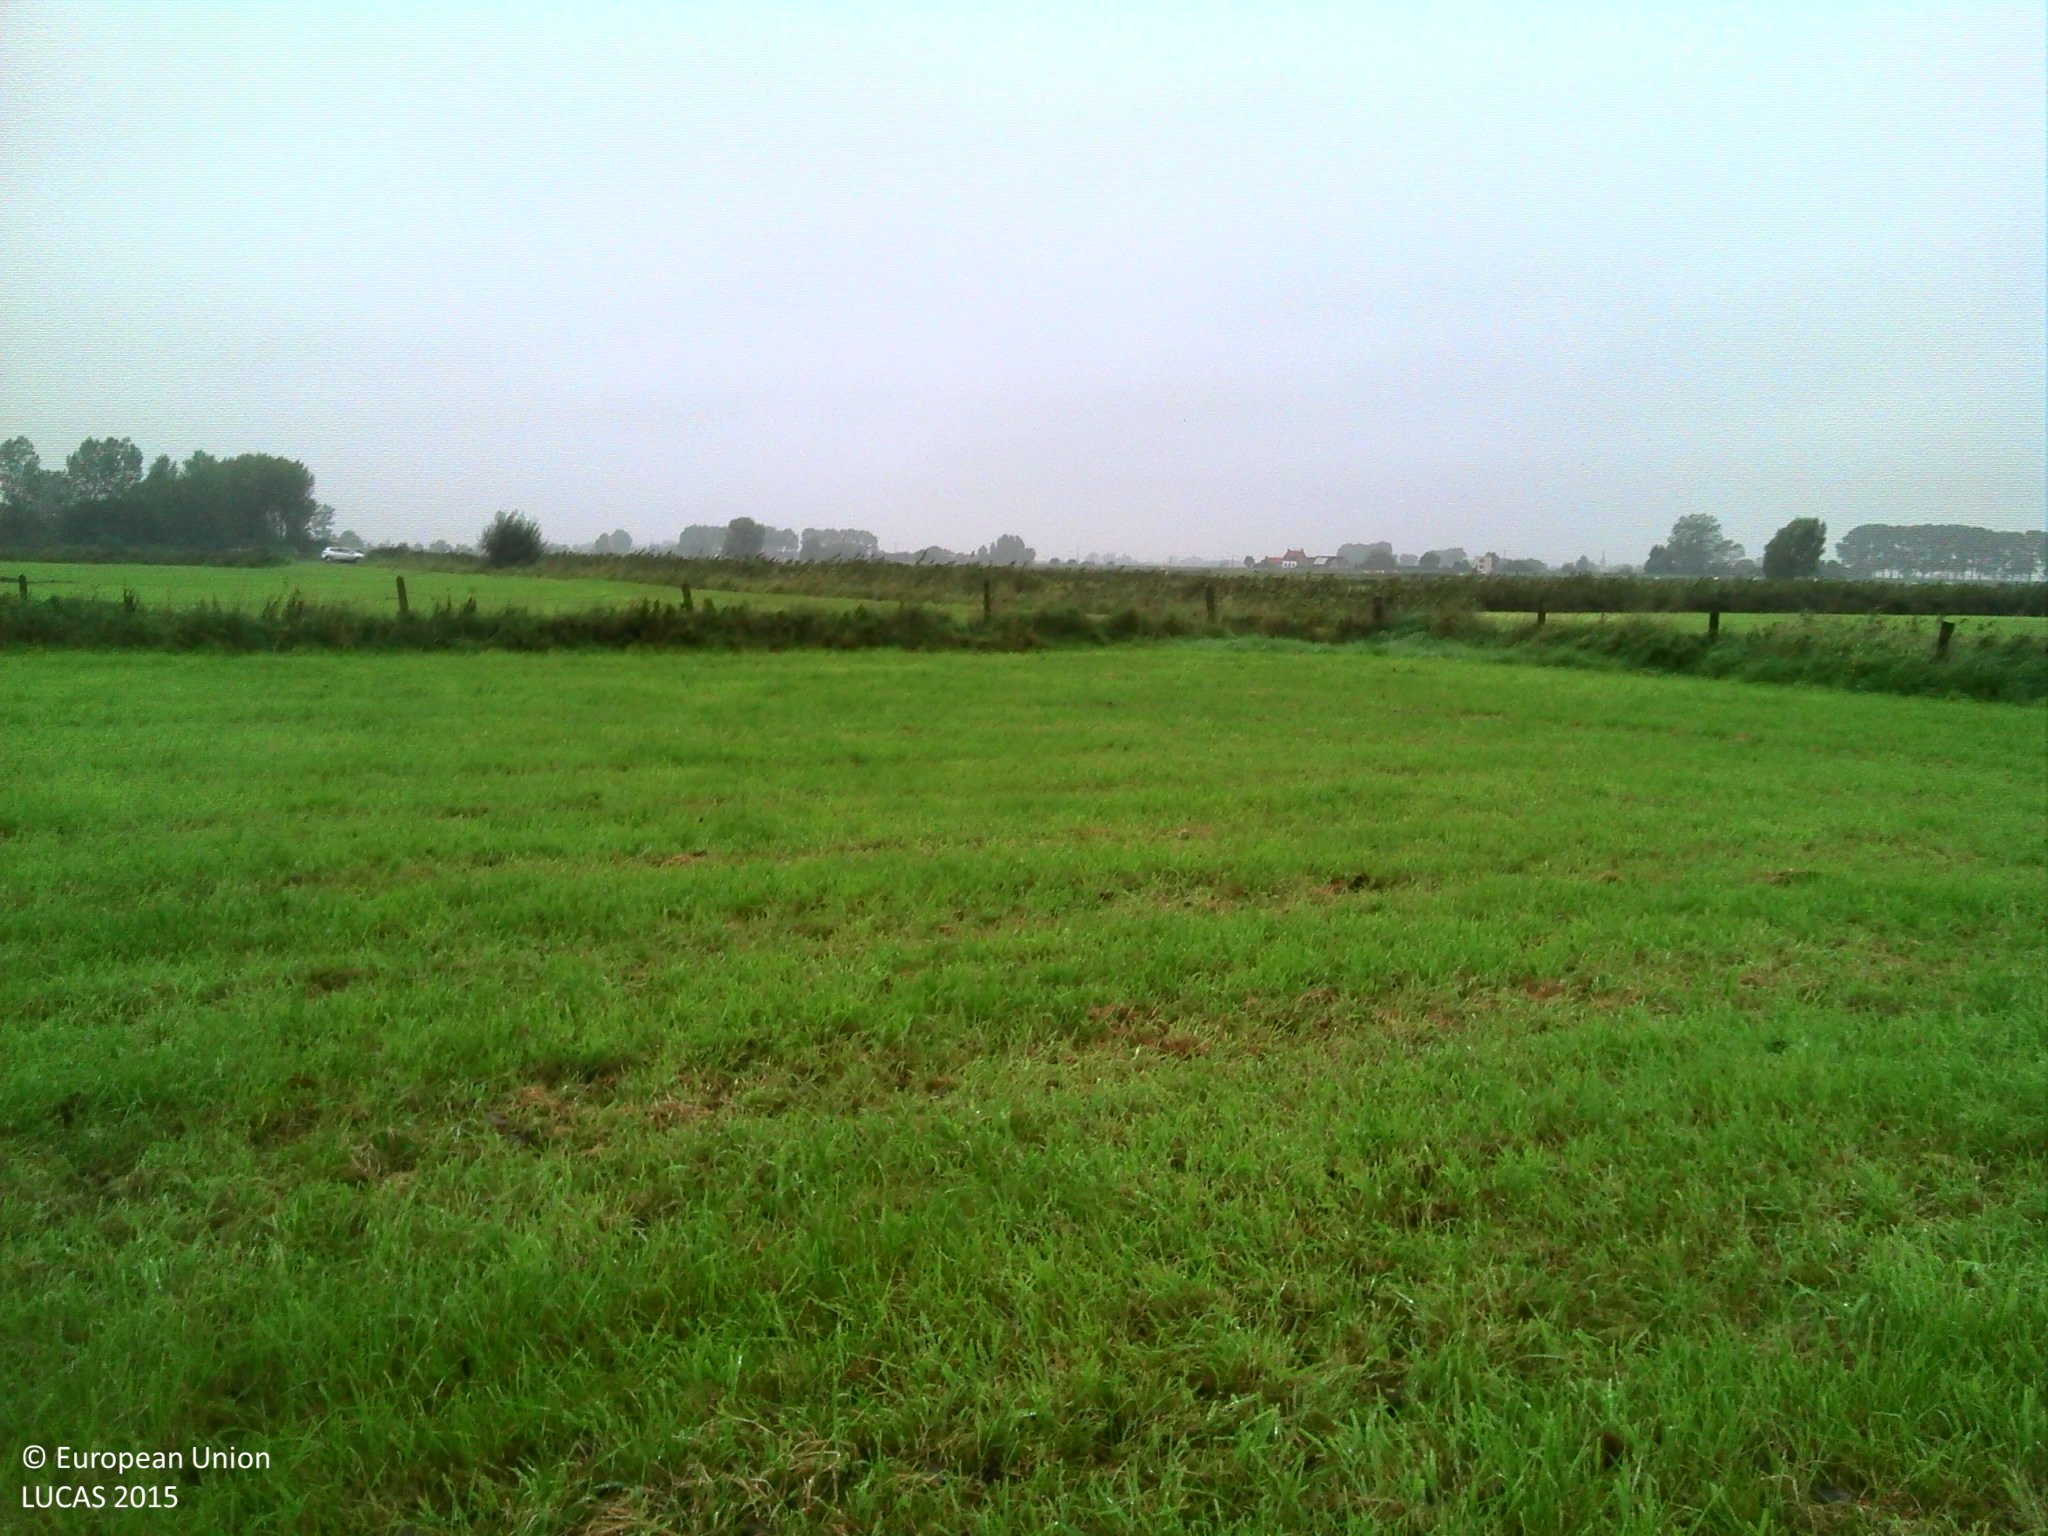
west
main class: Grassland
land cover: Grassland without tree/shrub cover
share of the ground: > 75 %
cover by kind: herbaceous plants 100 %
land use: Agriculture (excluding fallow land and kitchen gardens)
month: October
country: BE
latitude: 51.0066
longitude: 2.8490
